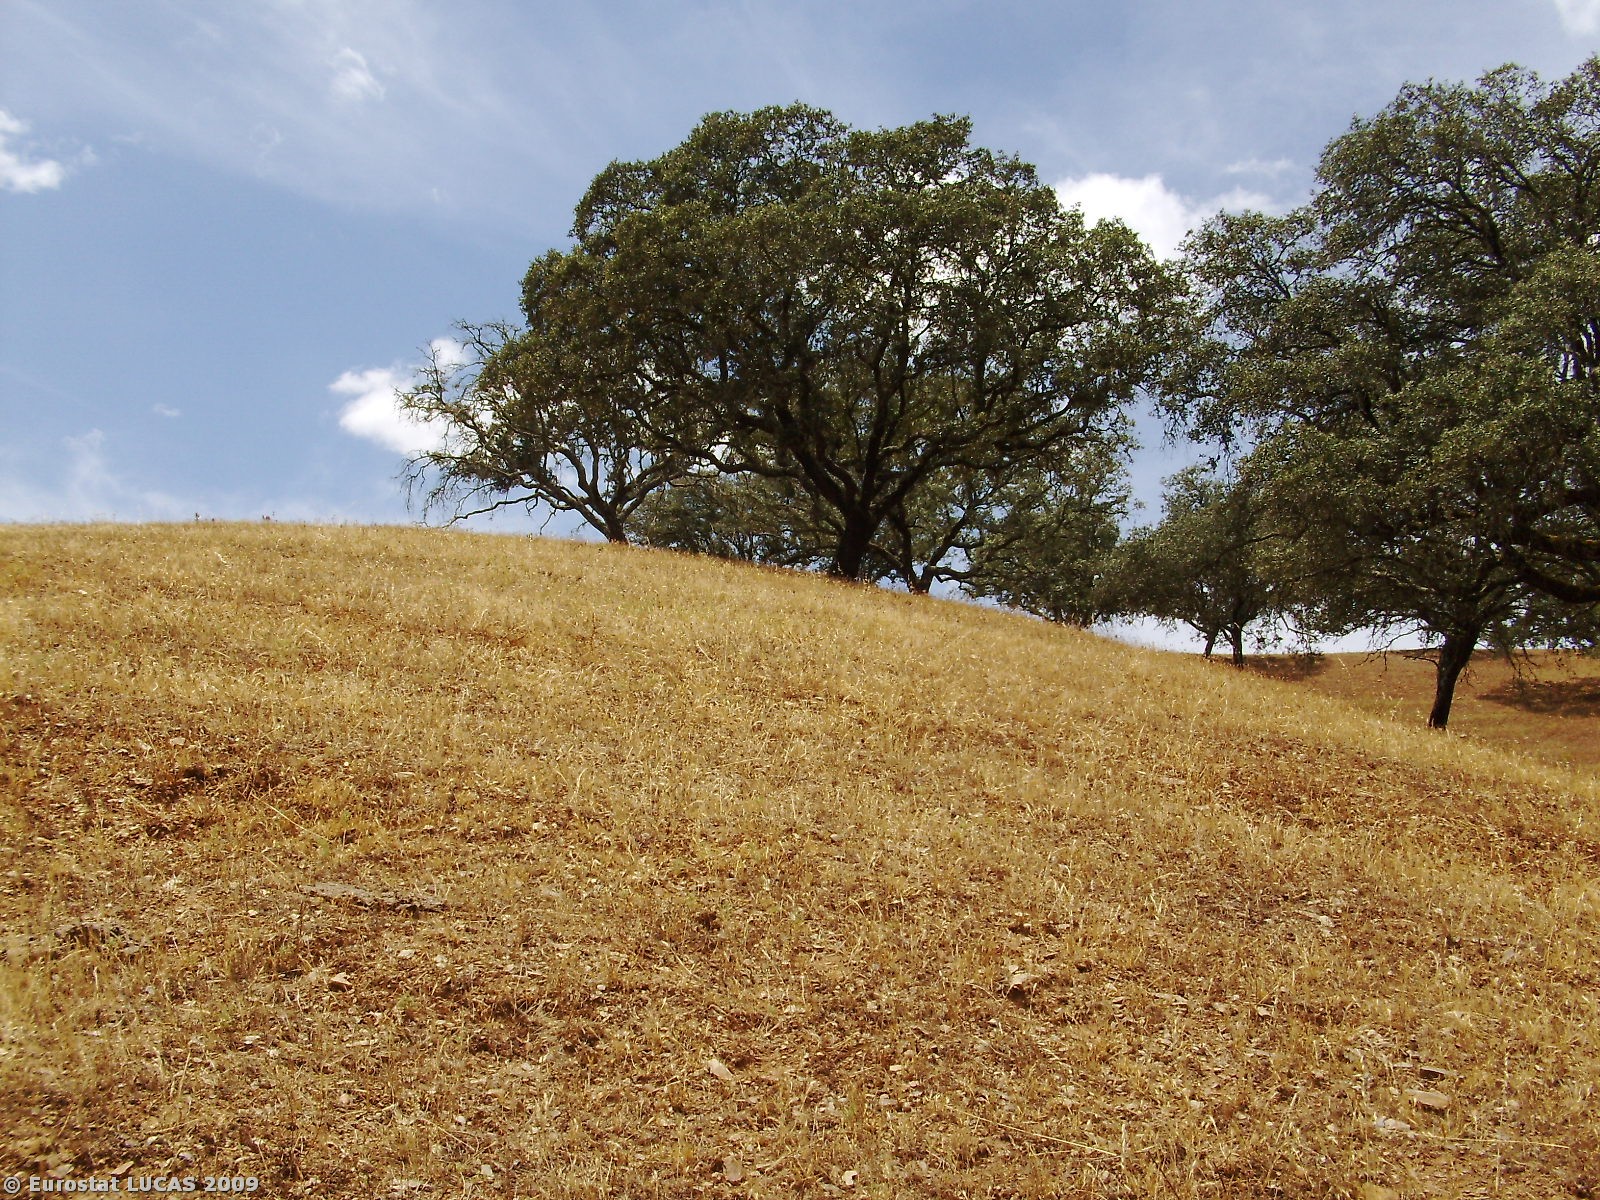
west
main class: Woodland
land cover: Broadleaved woodland
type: broadleaved evergreen forest
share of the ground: 10 - 25 %
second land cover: Spontaneously vegetated surfaces
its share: 50 - 75 %
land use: Forestry
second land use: Fallow land
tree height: > 5 m
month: June
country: PT
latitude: 38.0608
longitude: -8.5199
